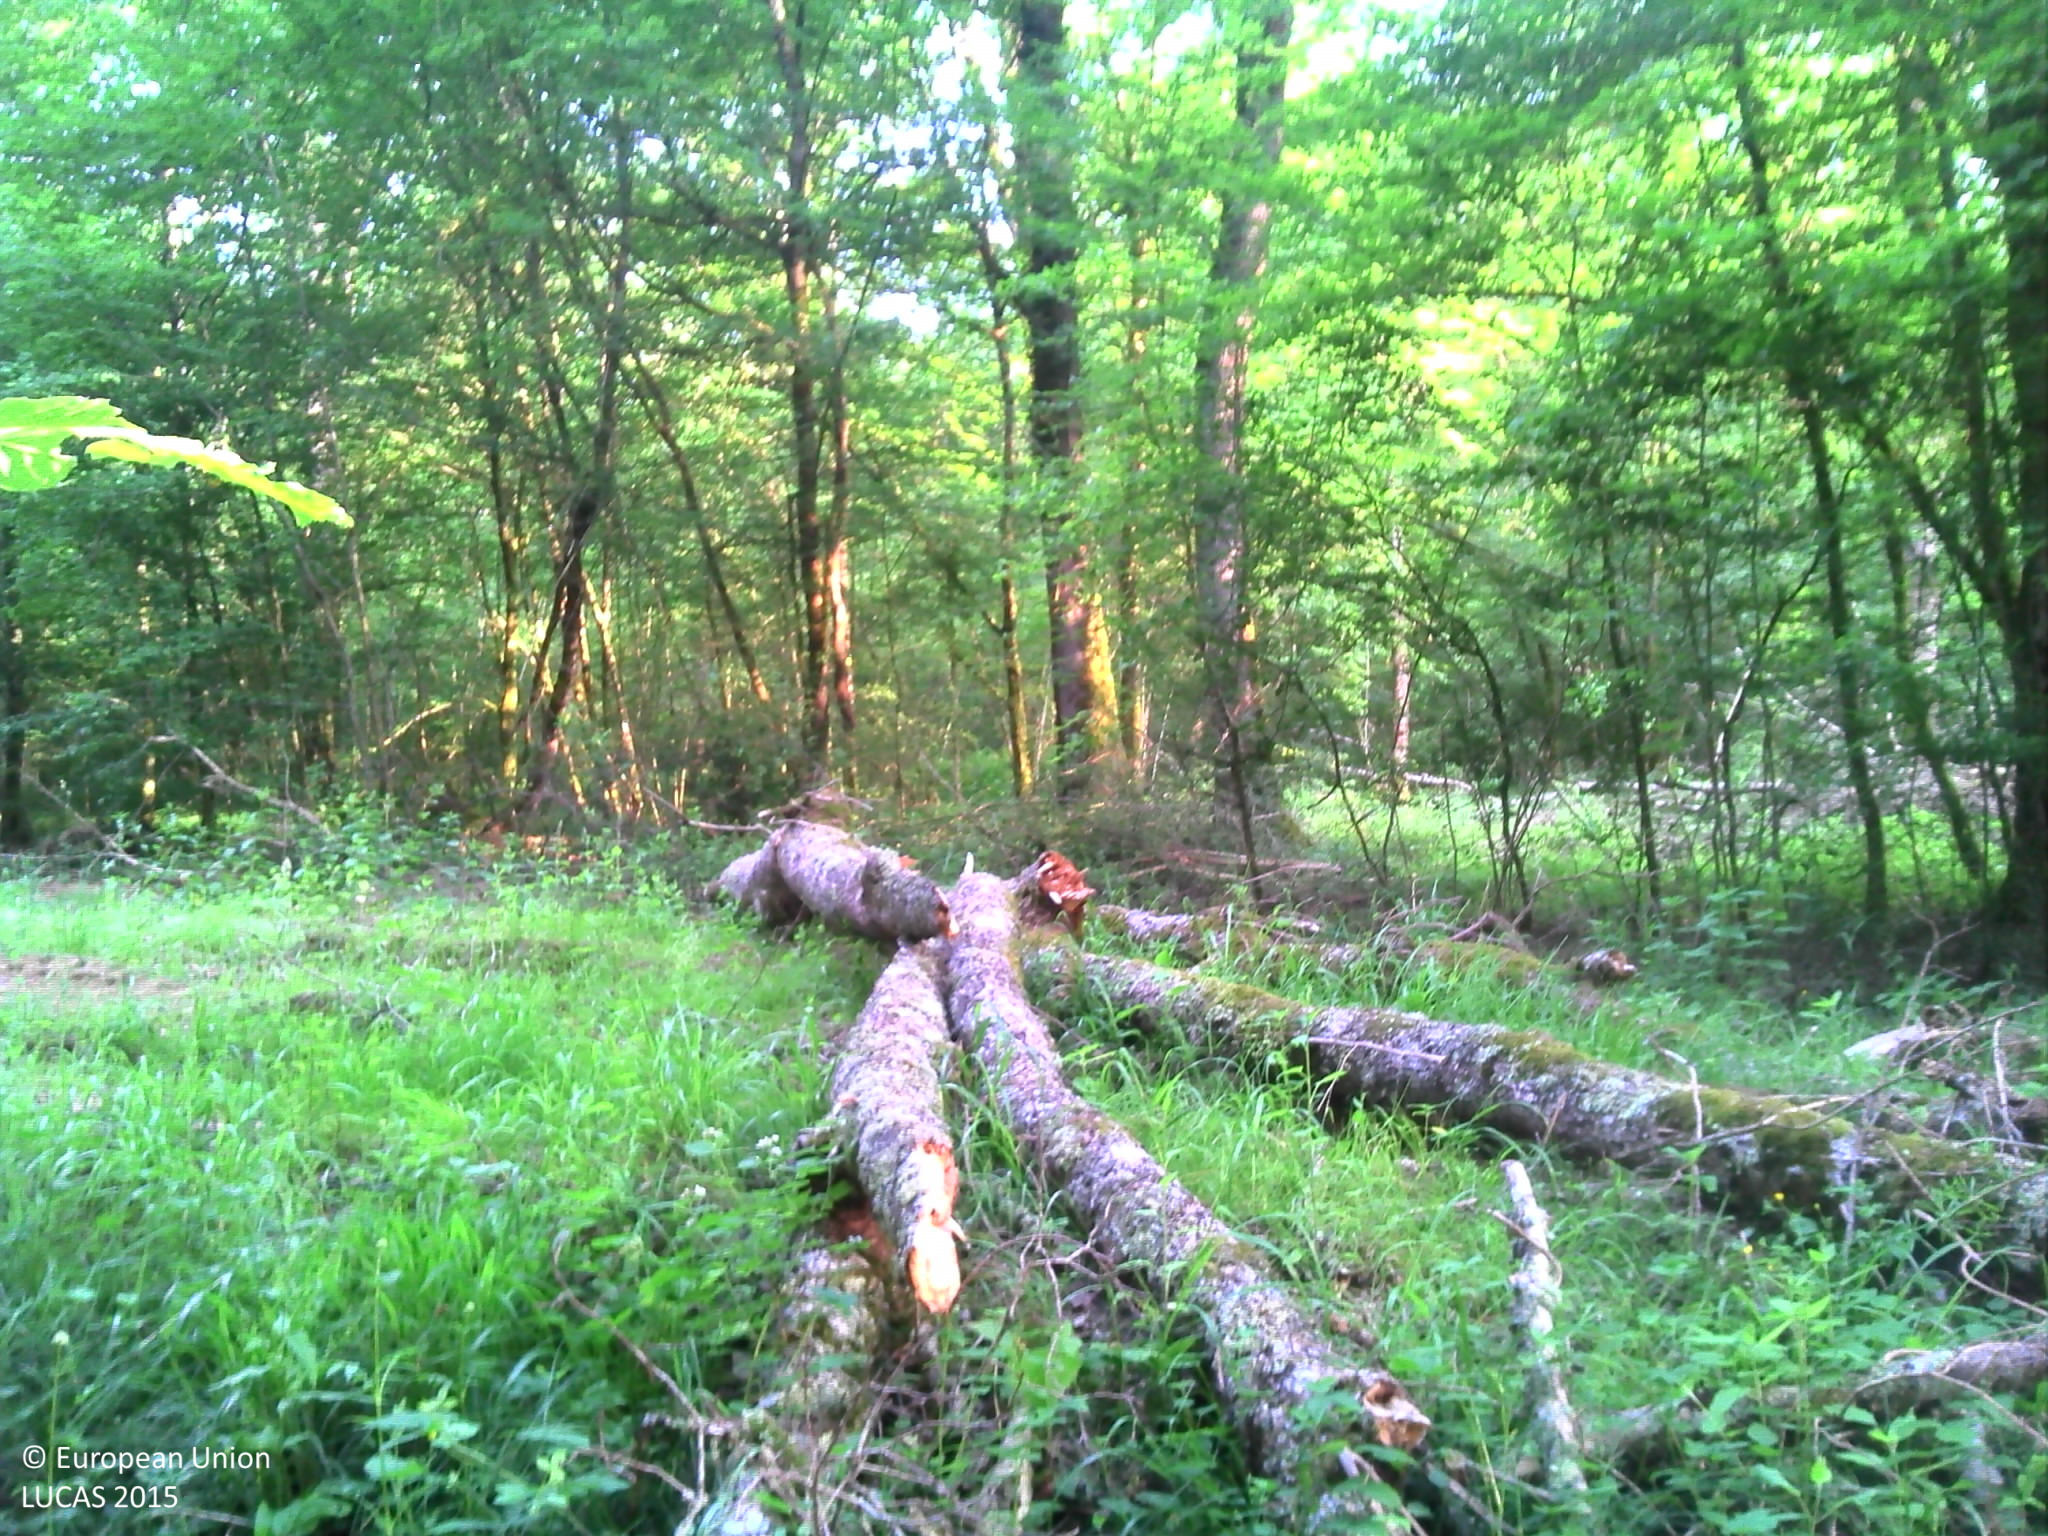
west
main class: Woodland
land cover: Broadleaved woodland
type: mesophytic deciduous forest
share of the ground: > 75 %
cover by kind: broadleaved forest trees 95 %, herbaceous plants 5 %
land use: Forestry
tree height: > 5 m
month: June
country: FR
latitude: 47.7958
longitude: 6.1428
